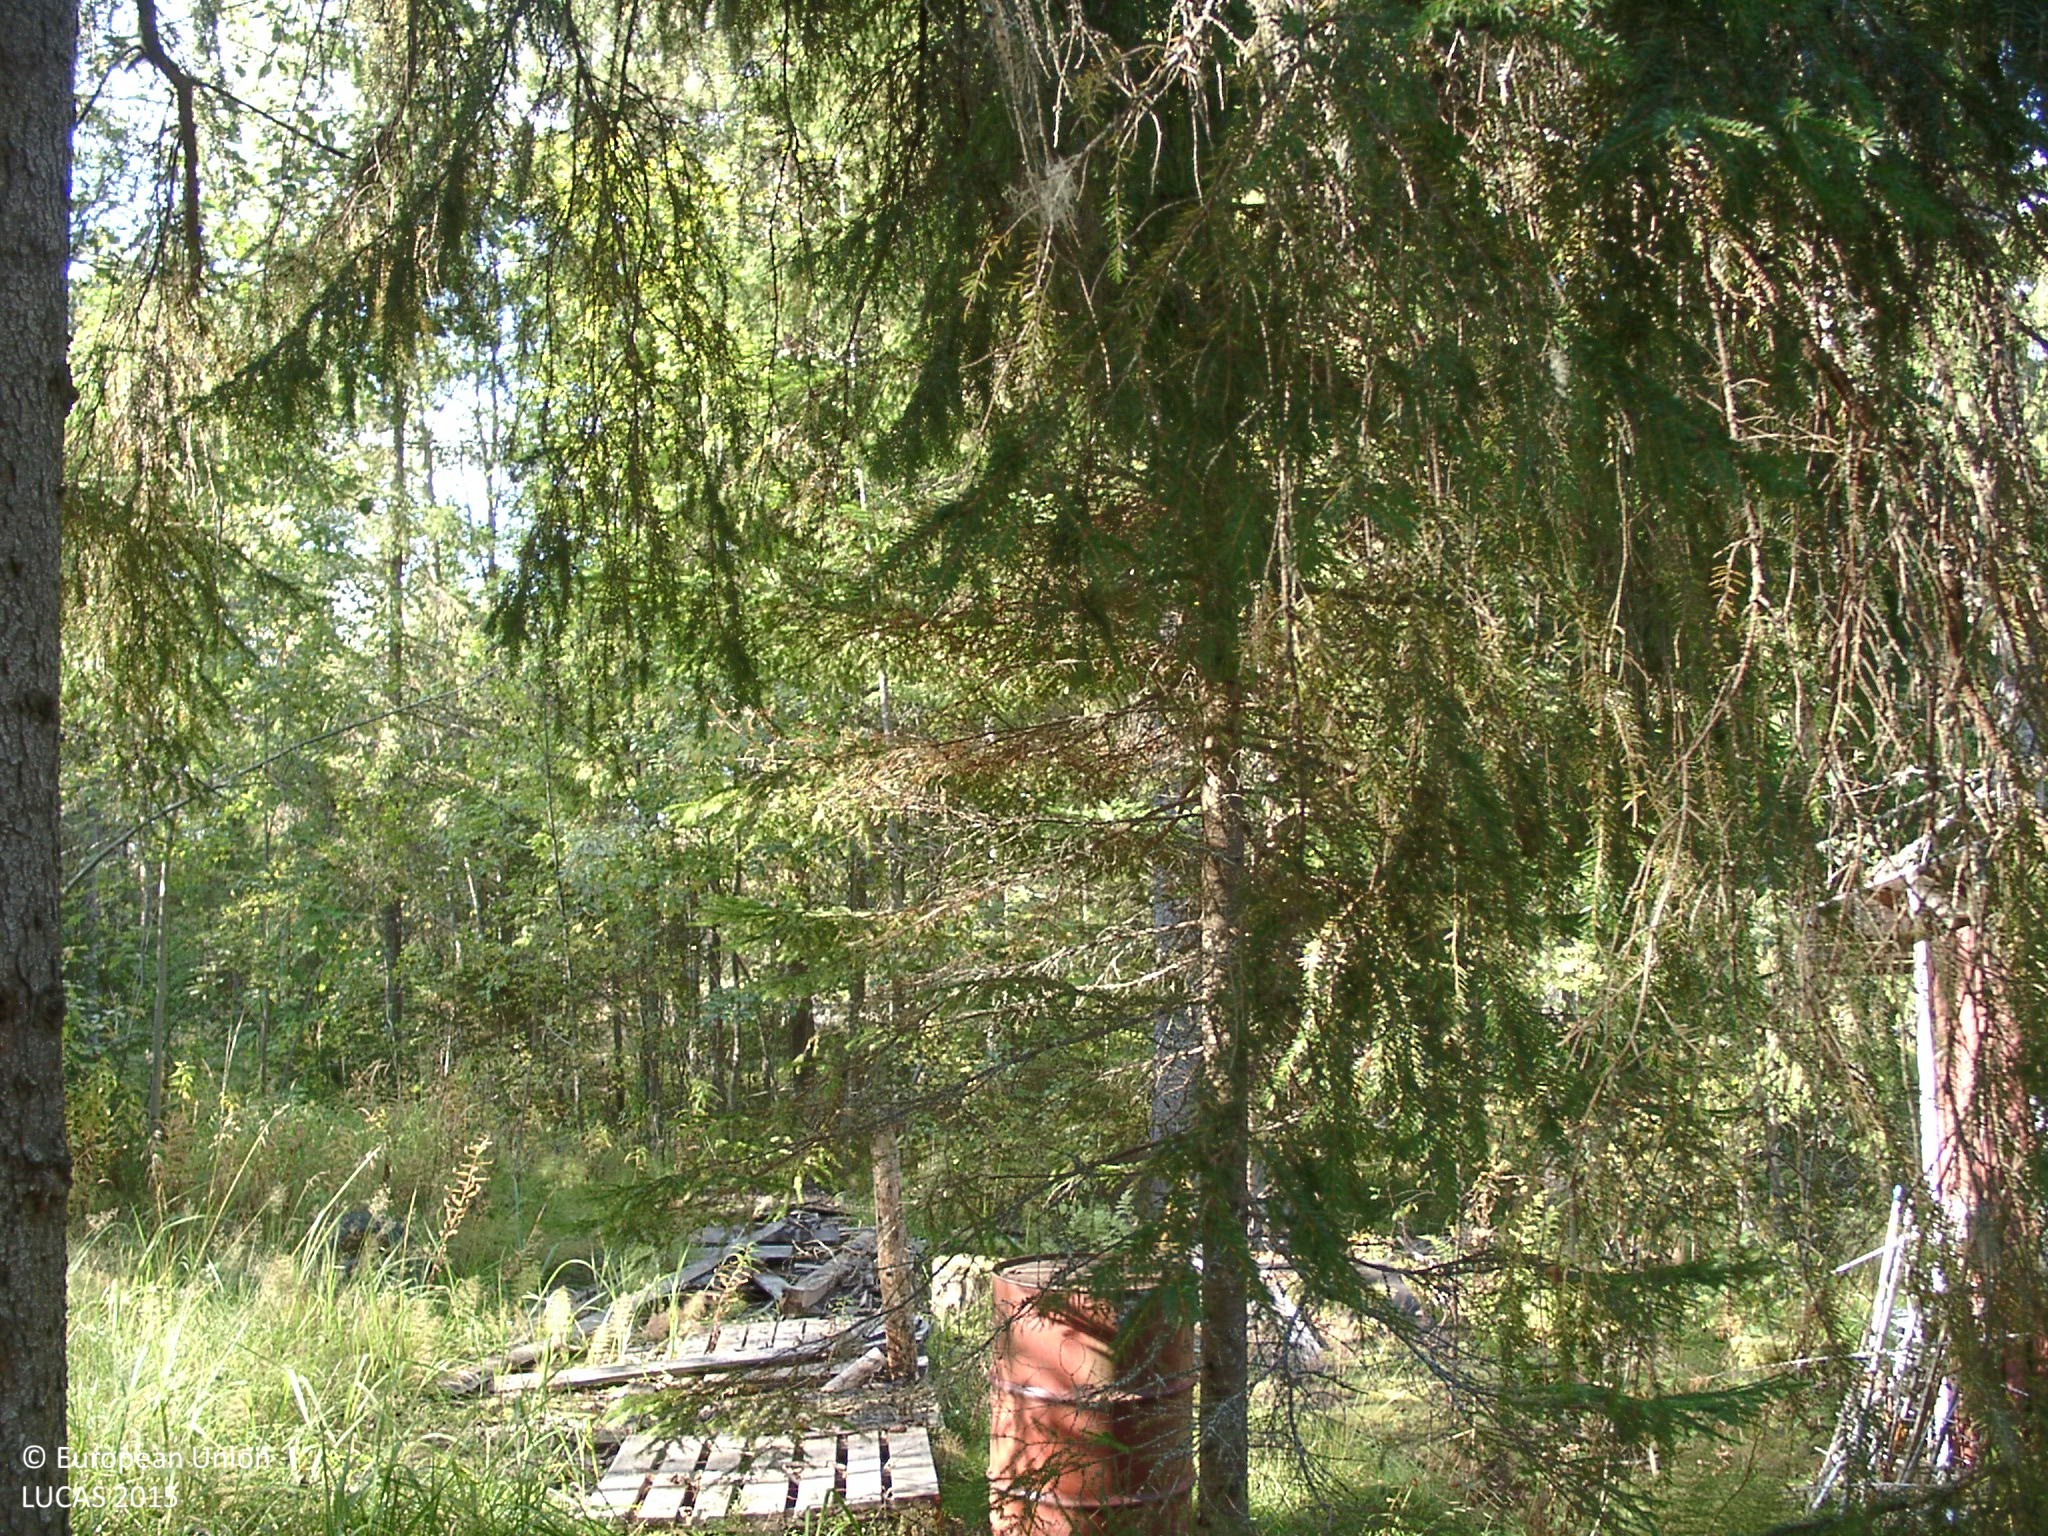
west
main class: Grassland
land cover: Grassland with sparse tree/shrub cover
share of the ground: 50 - 75 %
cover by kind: herbaceous plants 50 %, unconsolidated bare surface 15 %, lichens and mosses 10 %, broadleaved forest trees 5 %
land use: Residential
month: September
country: FI
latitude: 62.4692
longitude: 25.6491
